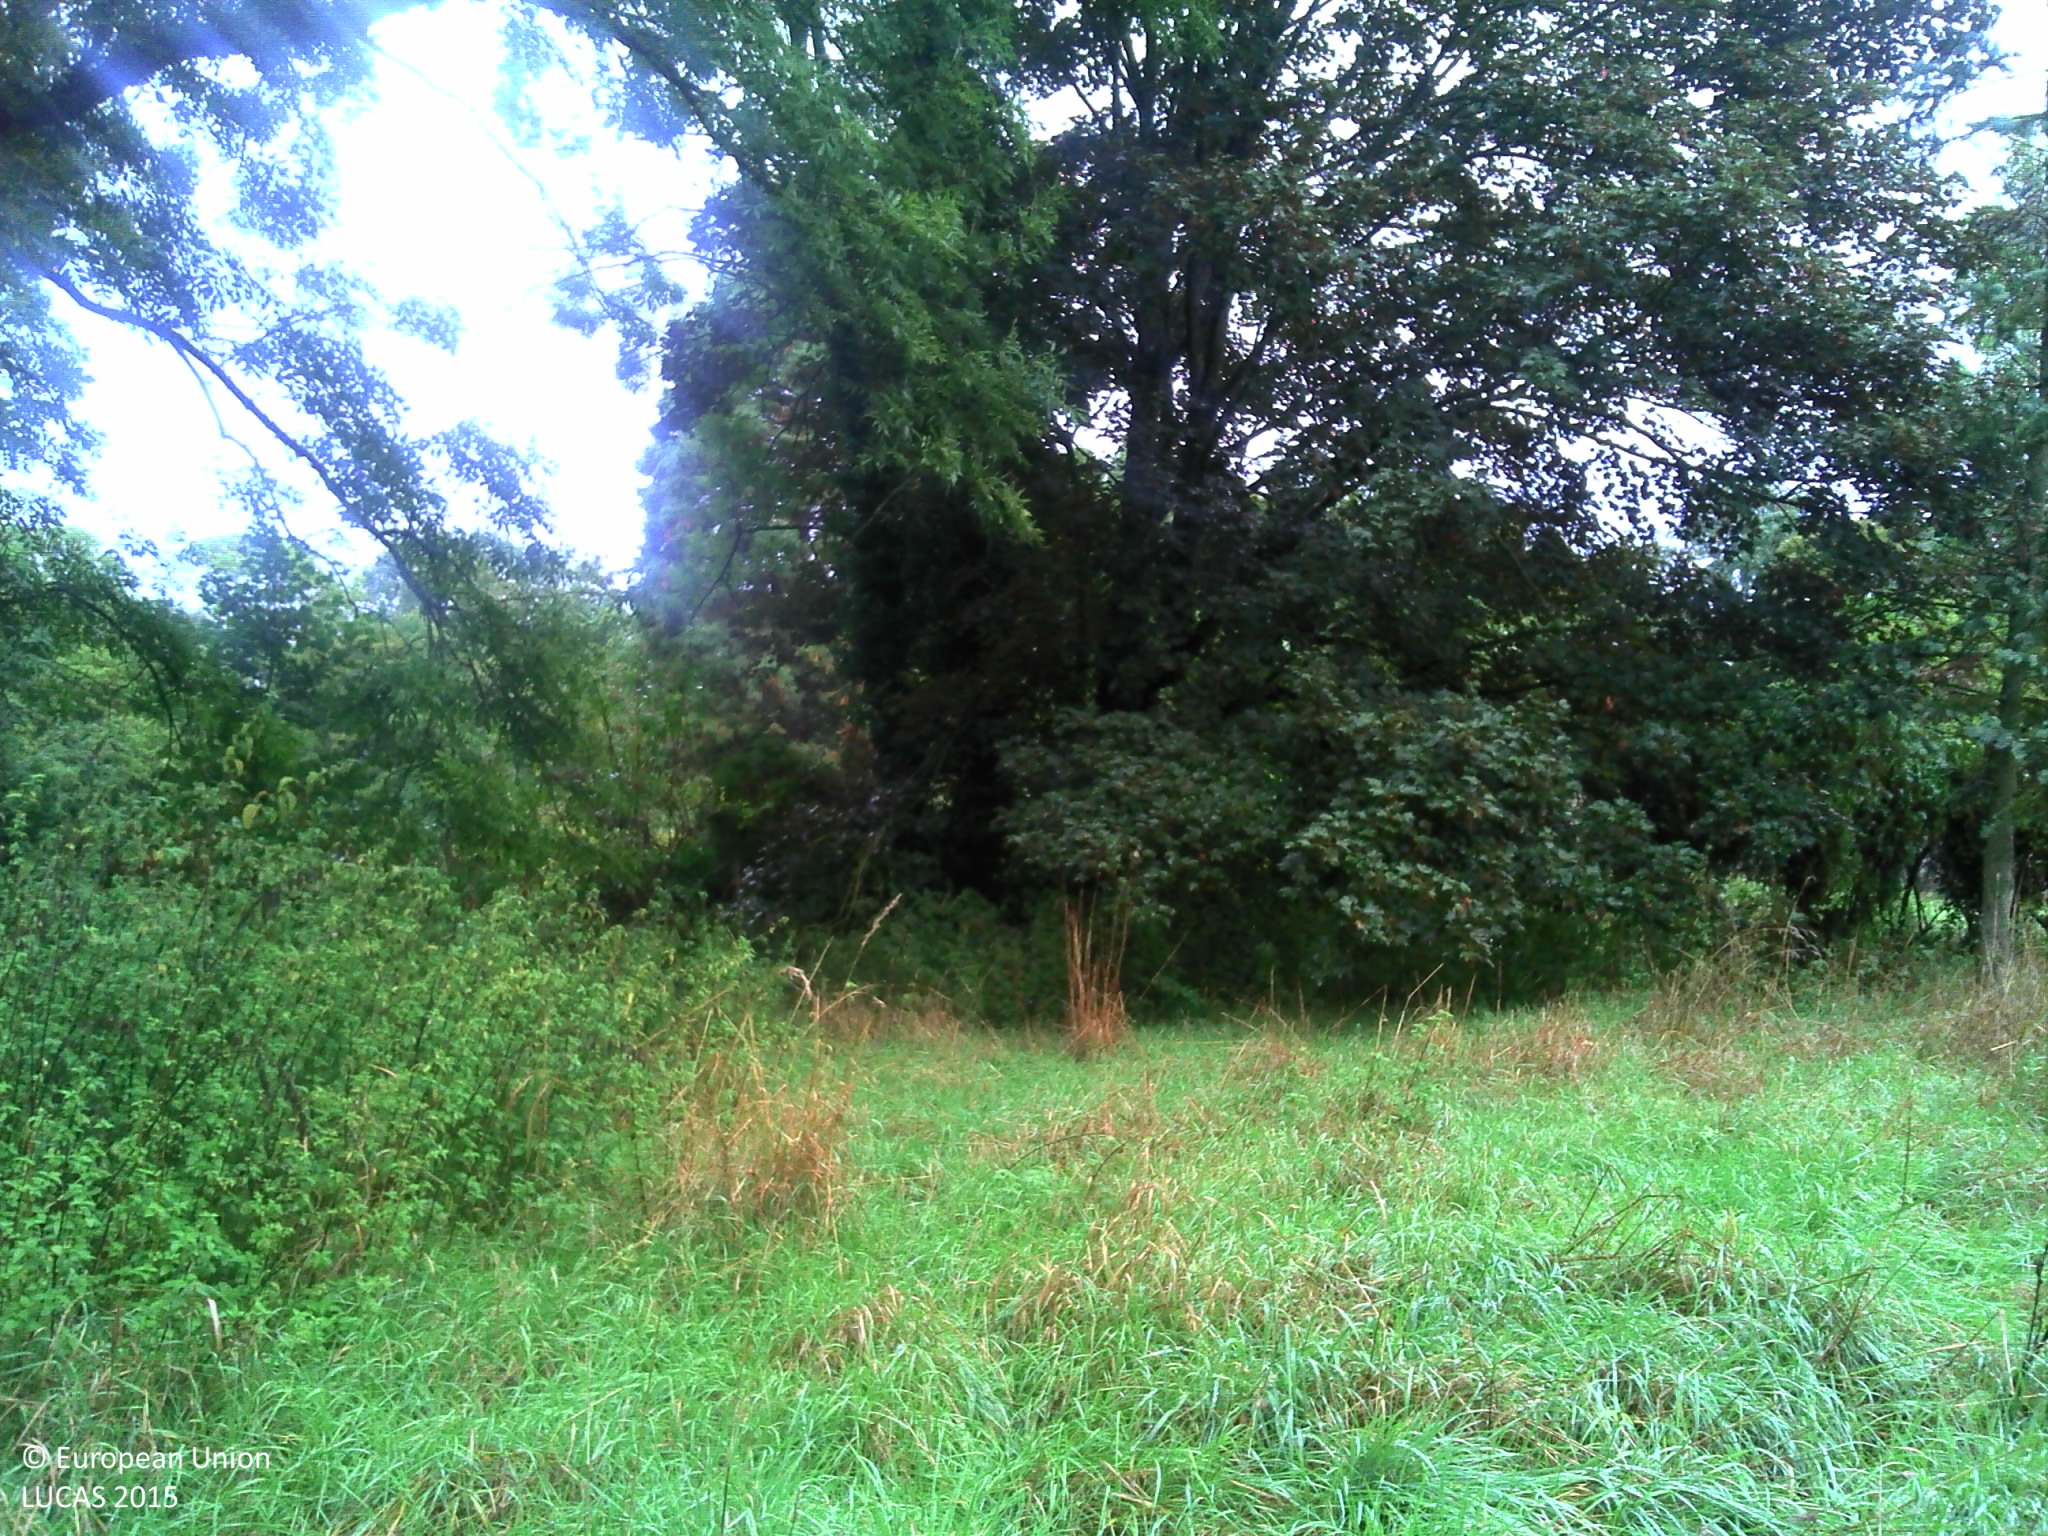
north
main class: Grassland
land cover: Grassland with sparse tree/shrub cover
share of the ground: > 75 %
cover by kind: herbaceous plants 85 %, consolidated bare surface 10 %, broadleaved forest trees 5 %
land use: Community services
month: September
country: FR
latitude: 48.7338
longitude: 6.1794
